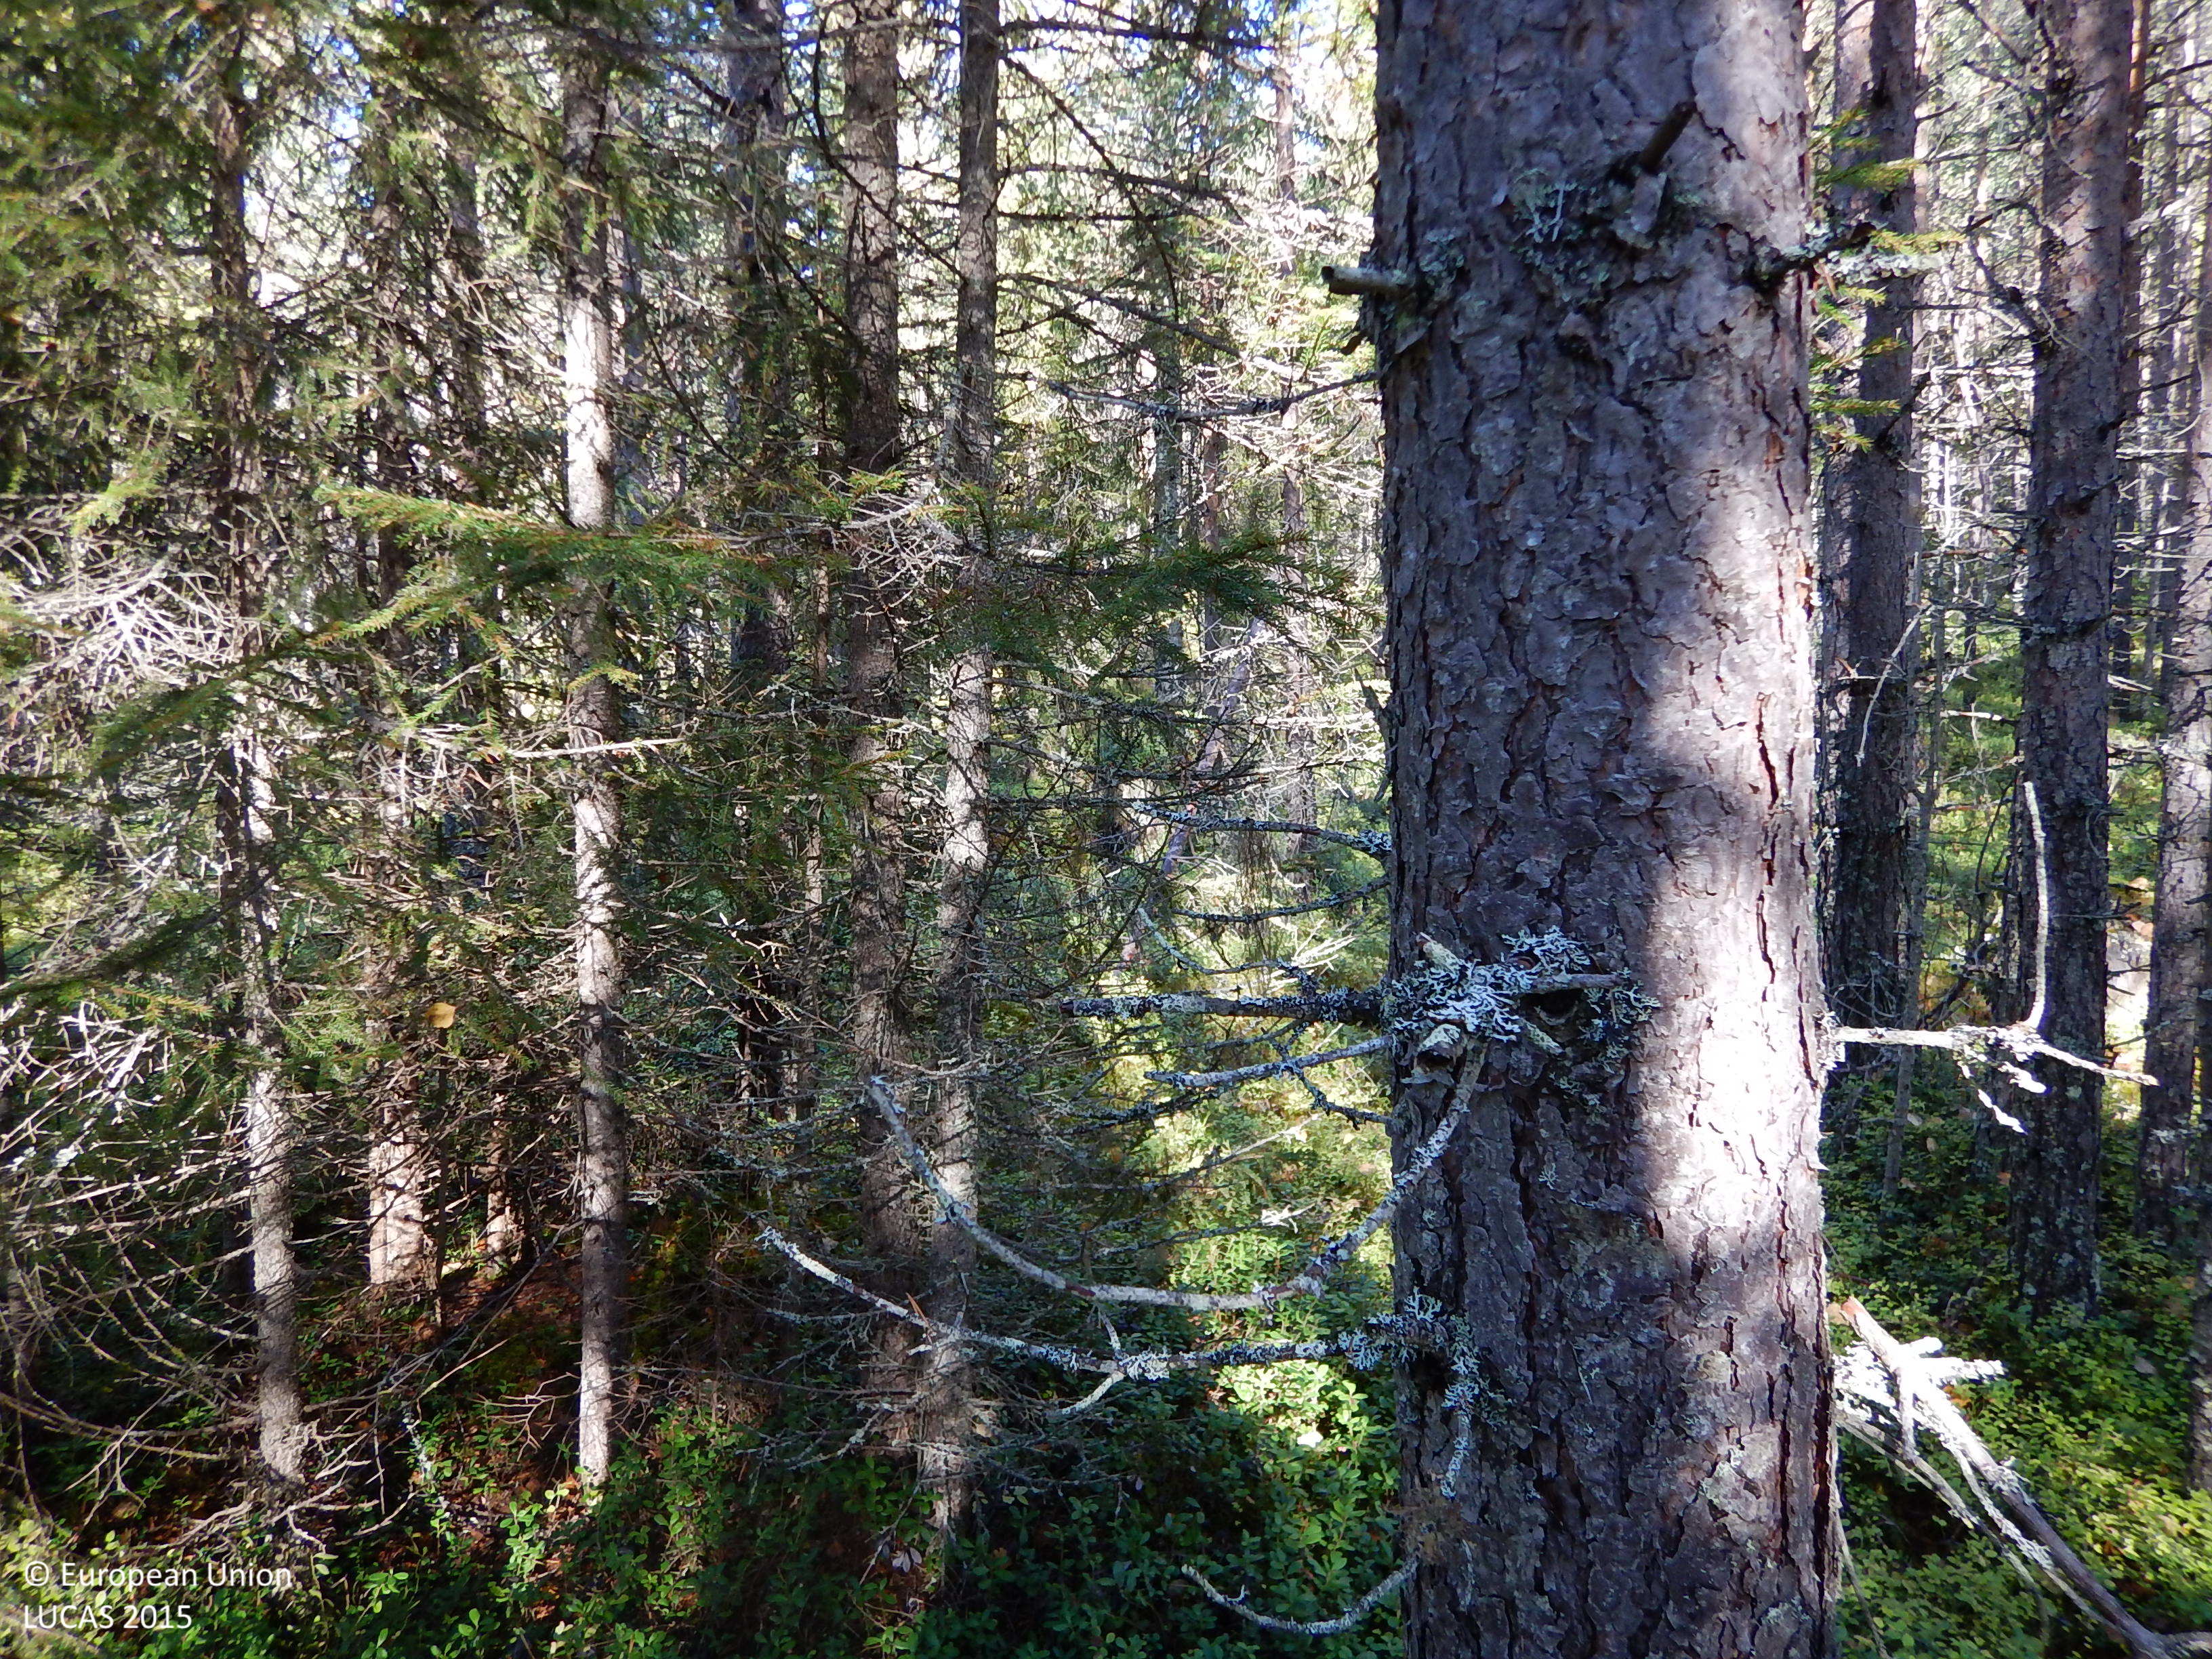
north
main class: Woodland
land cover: Other coniferous woodland
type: boreal forest
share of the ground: 50 - 75 %
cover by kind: coniferous forest trees 70 %, shrubs 15 %, lichens and mosses 10 %, herbaceous plants 5 %
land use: Forestry
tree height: > 5 m
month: September
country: SE
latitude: 64.9504
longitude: 20.1096
